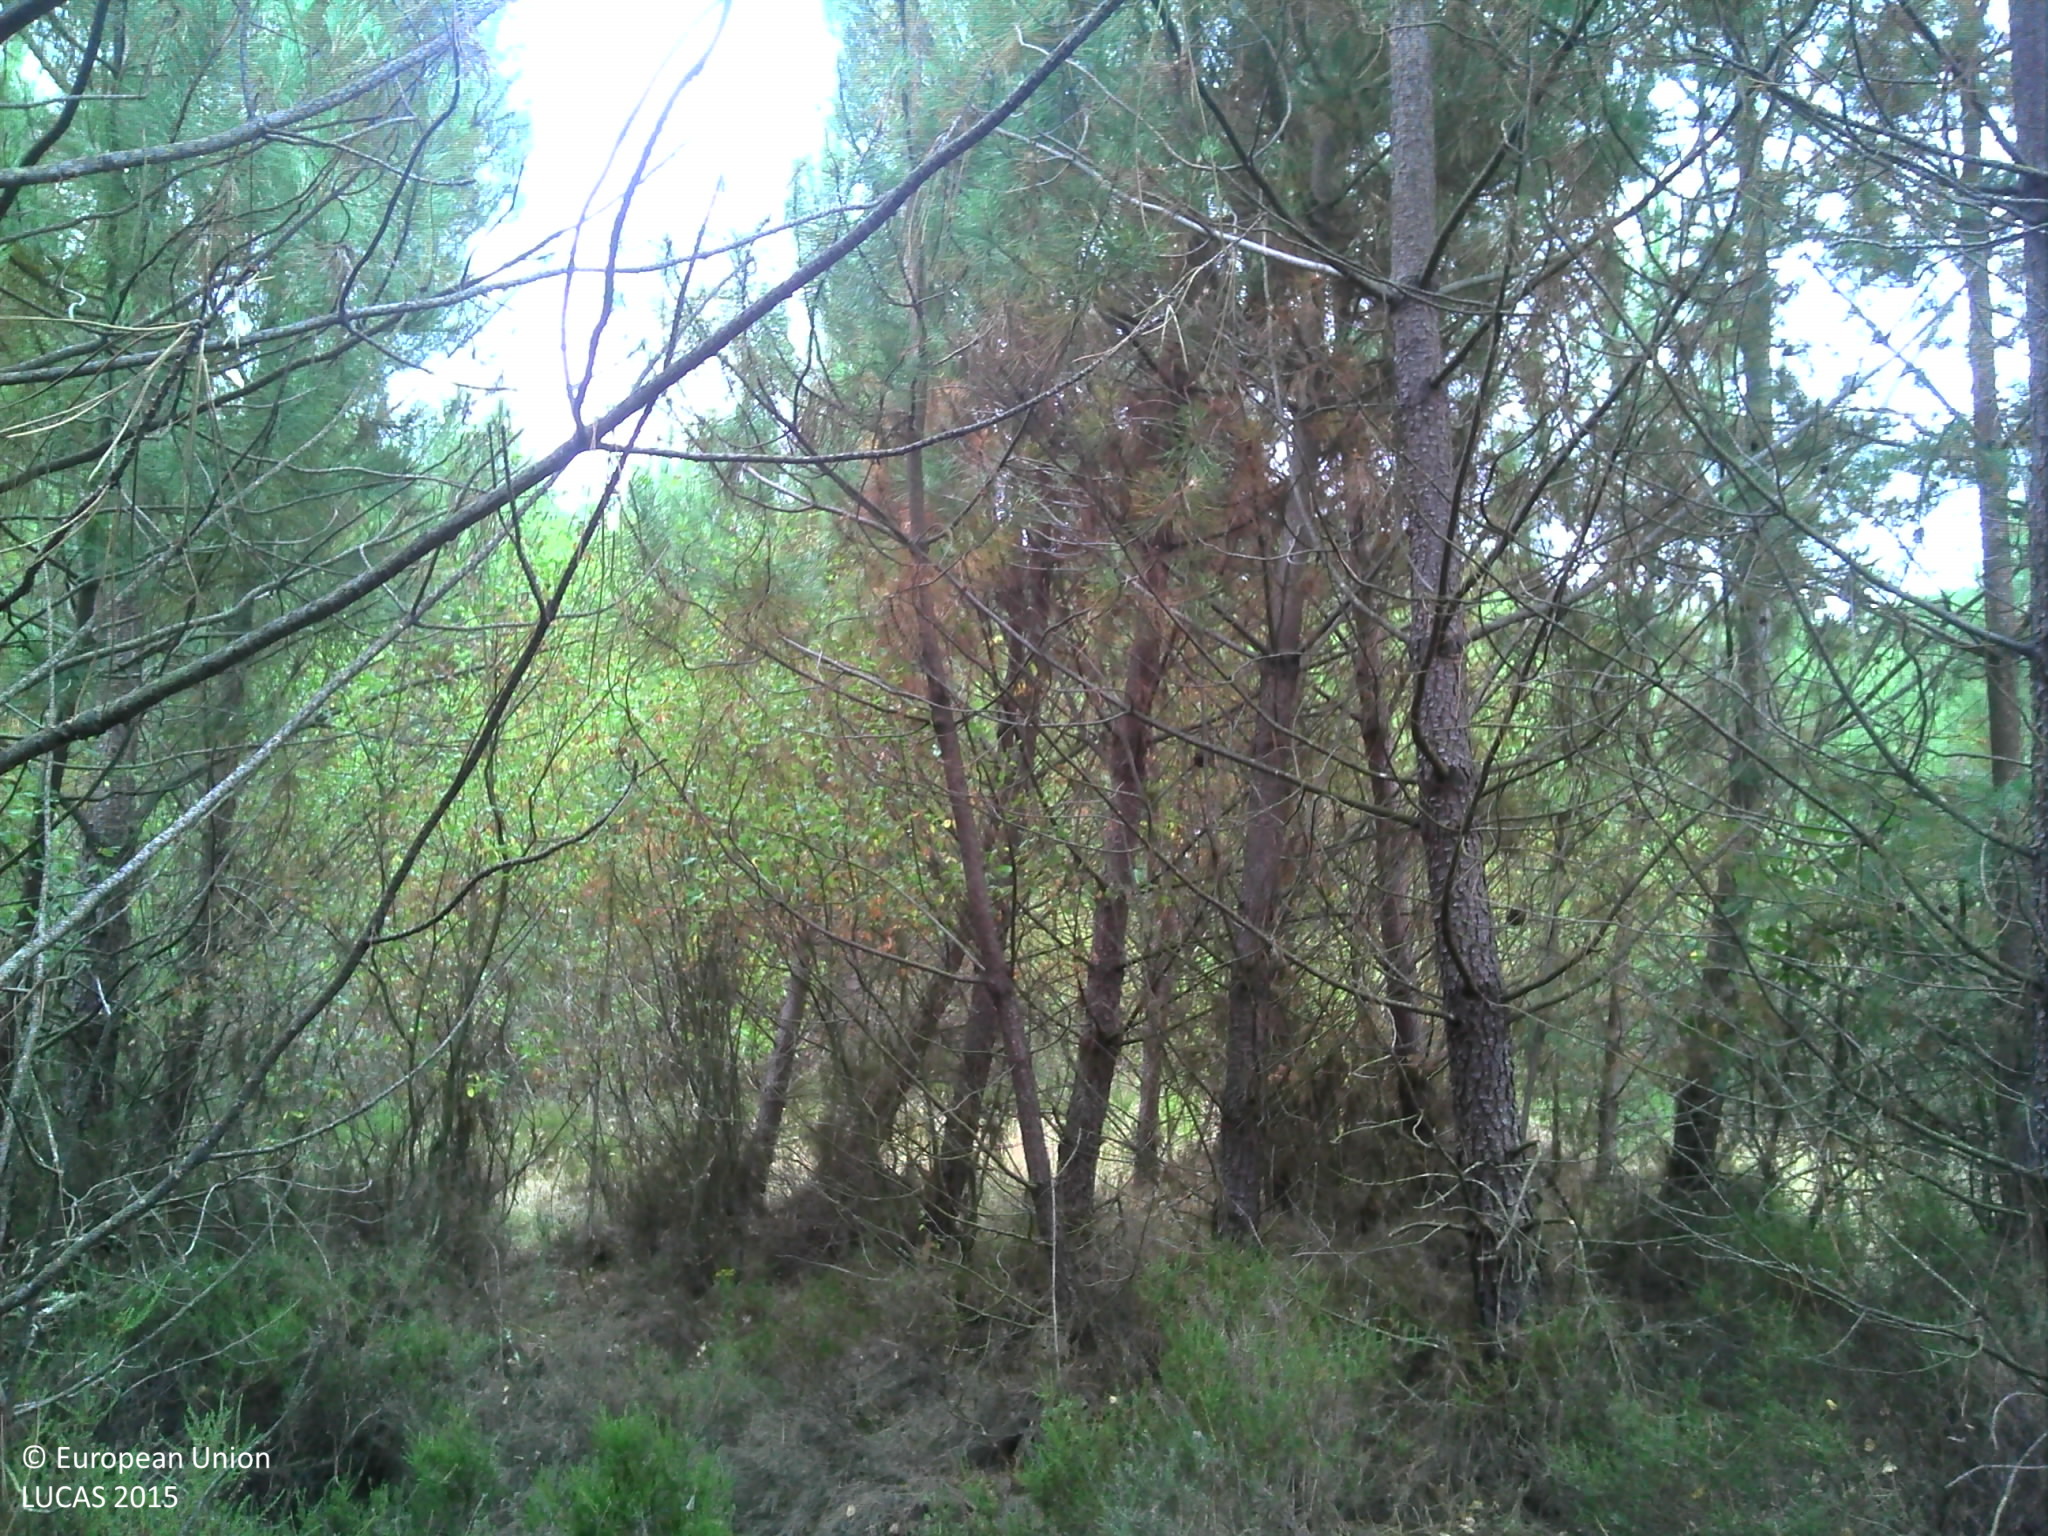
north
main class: Woodland
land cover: Pine dominated coniferous woodland
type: exotic forest
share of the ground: > 75 %
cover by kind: coniferous forest trees 70 %, shrubs 15 %, herbaceous plants 15 %
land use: Forestry
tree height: > 5 m
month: July
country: FR
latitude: 47.9240
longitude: 0.3263
